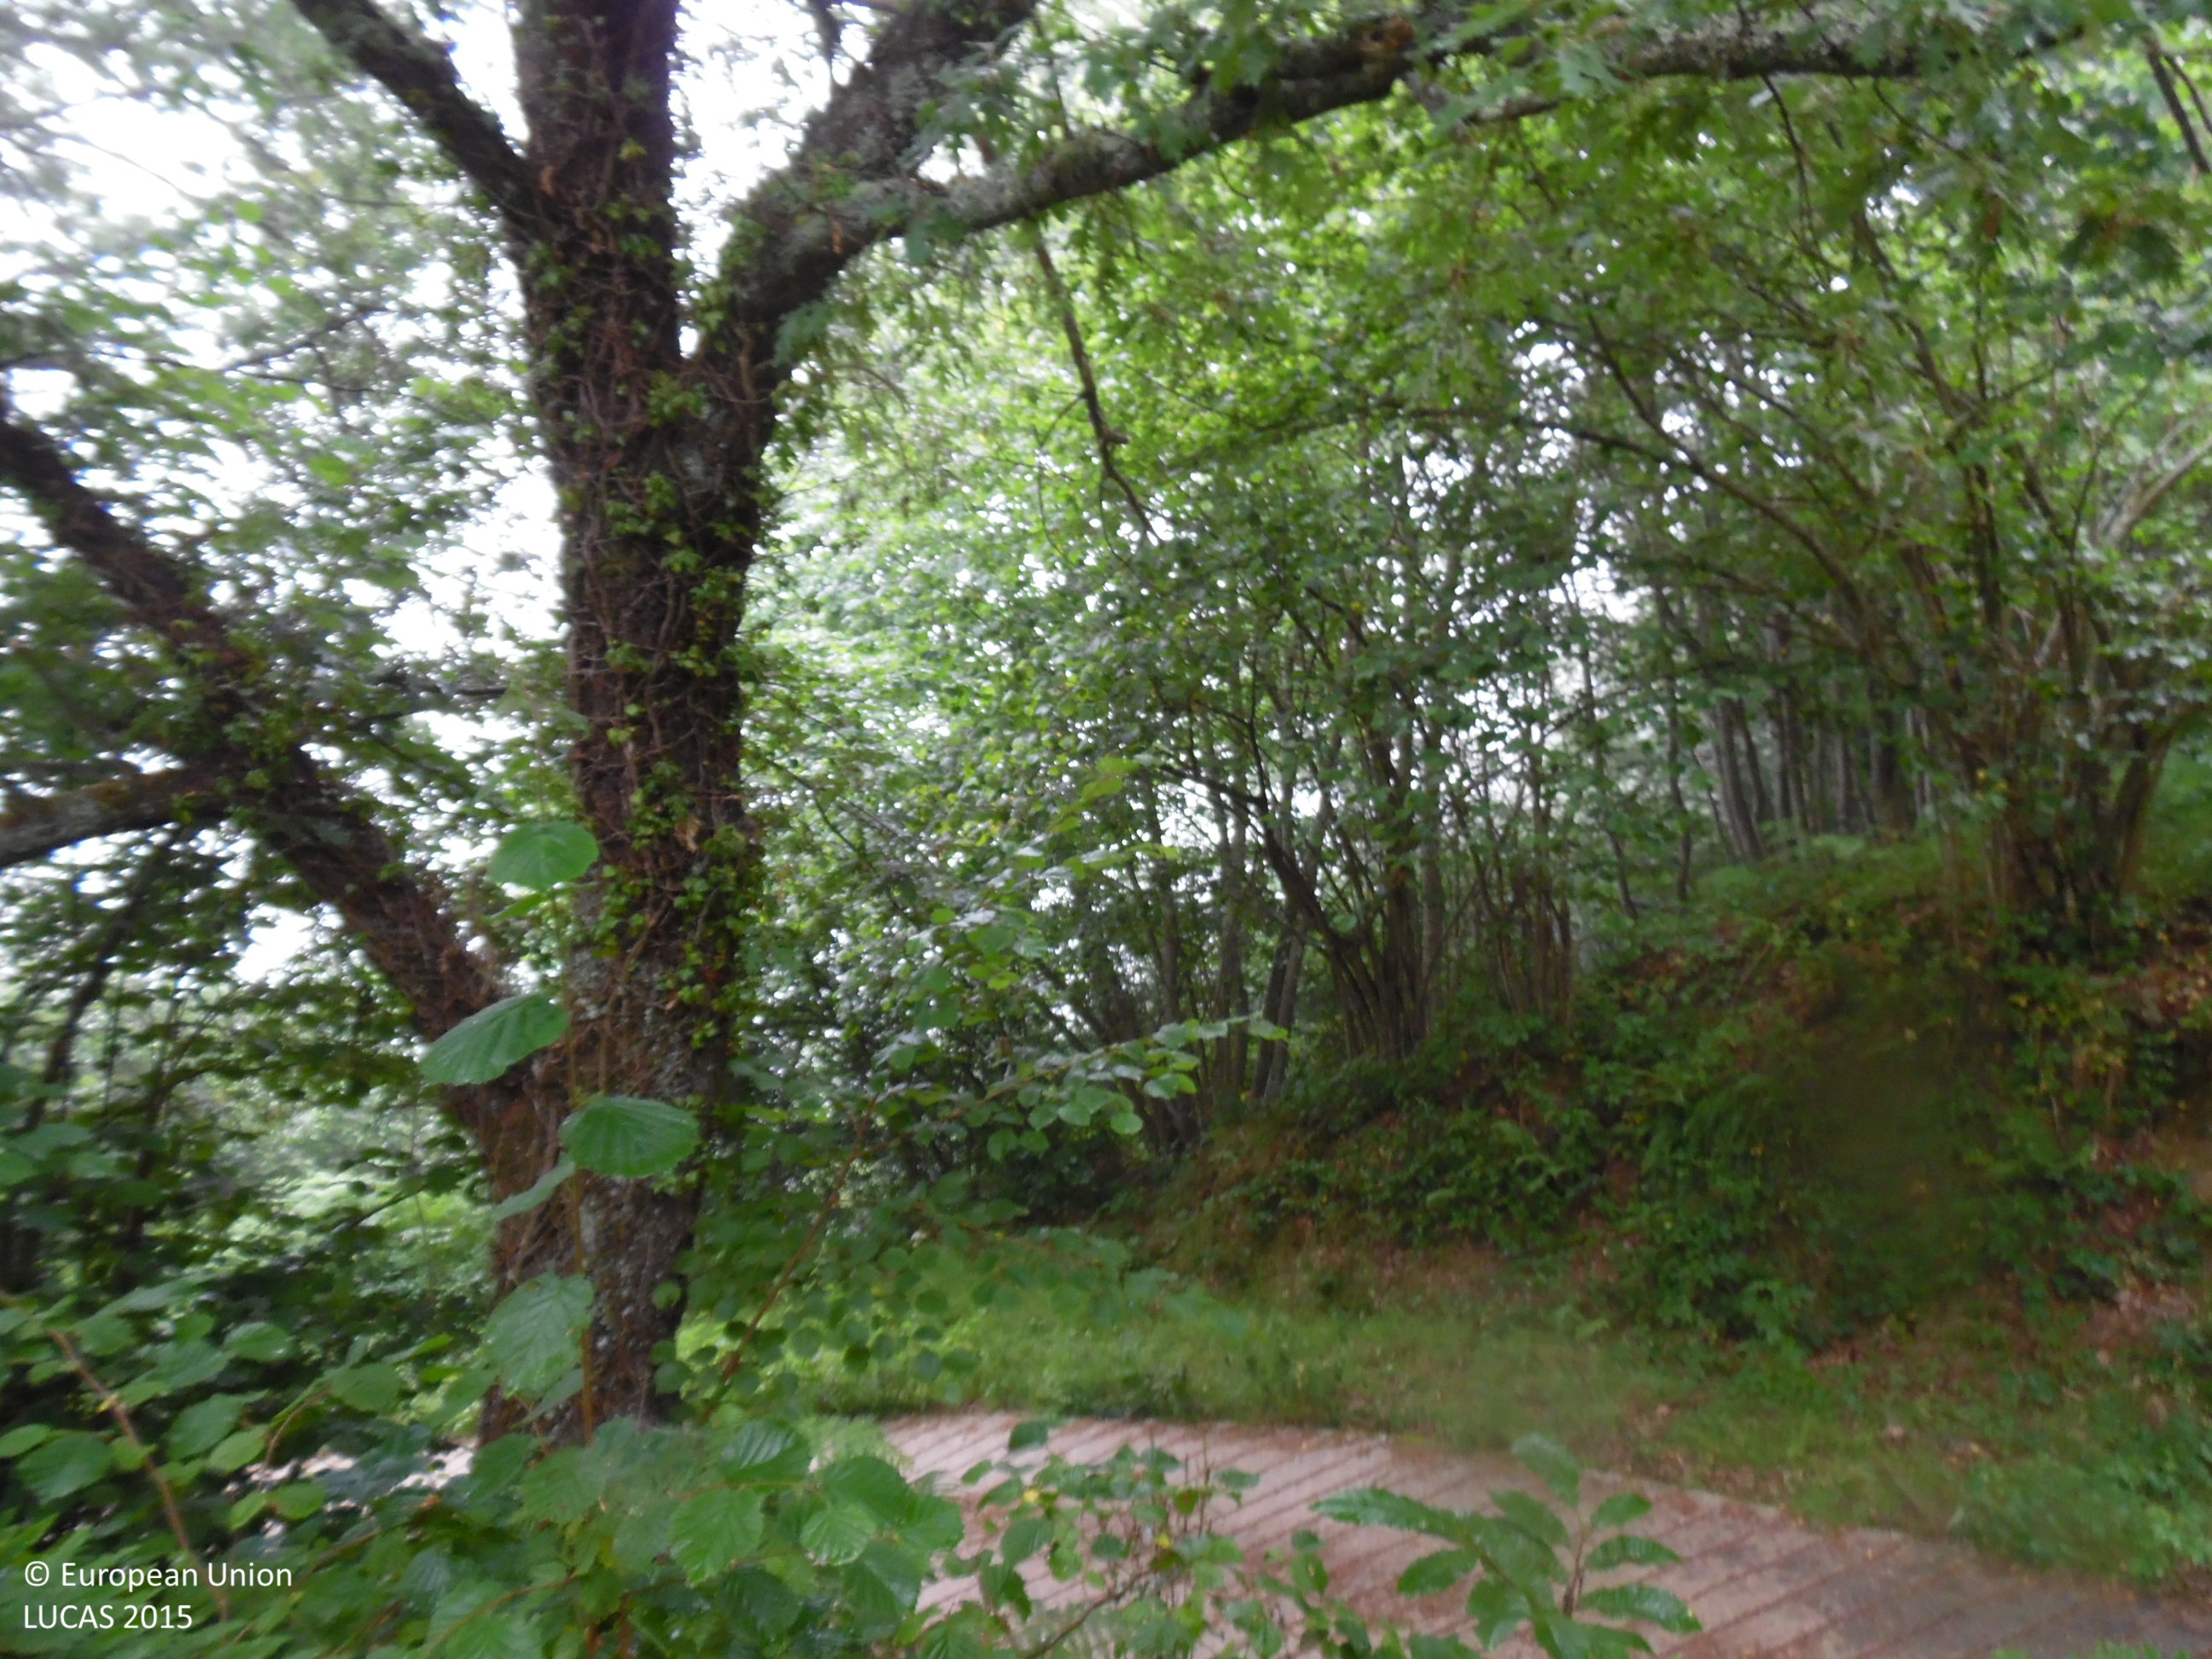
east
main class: Woodland
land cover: Broadleaved woodland
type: acidophilous oak and oak-birch forest
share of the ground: > 75 %
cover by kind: broadleaved forest trees 100 %
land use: Forestry
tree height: > 5 m
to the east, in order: Broadleaved woodland; Tracks; Broadleaved woodland; Grassland with sparse tree/shrub cover; Broadleaved woodland
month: July
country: ES
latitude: 43.1285
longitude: -5.9317
